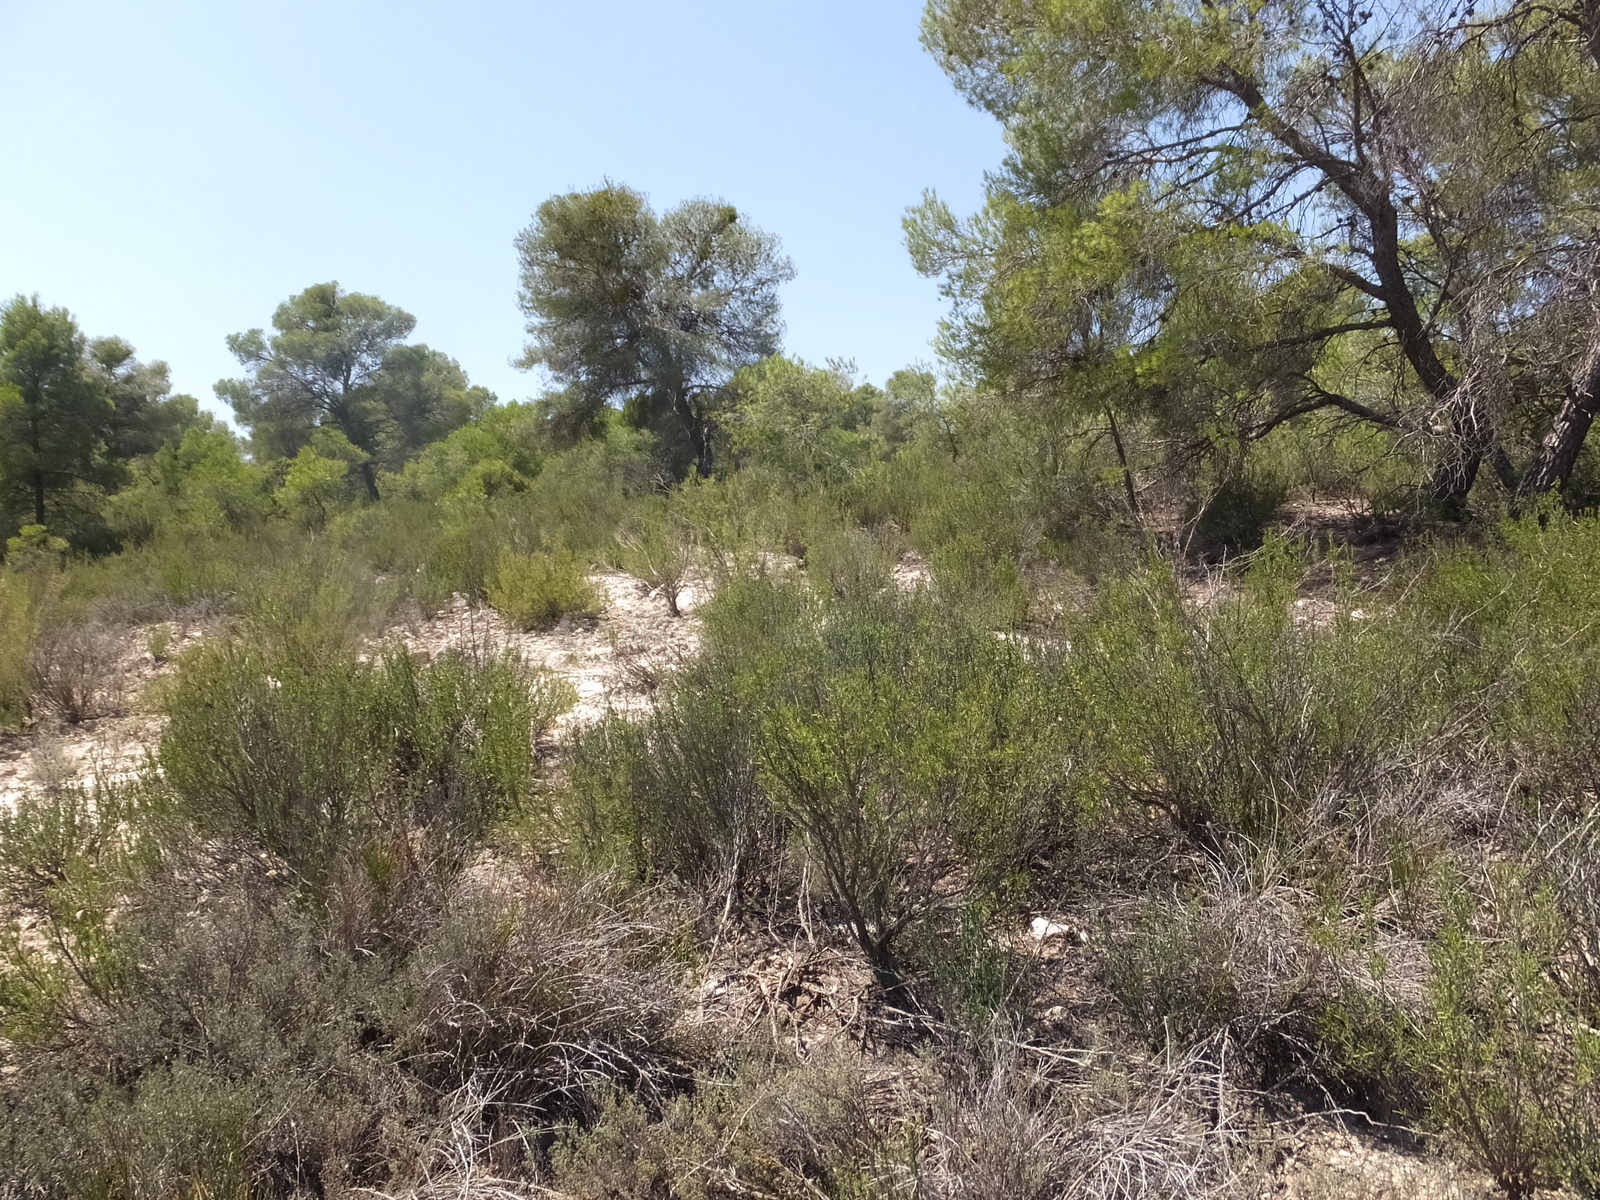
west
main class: Shrubland
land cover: Shrubland with sparse tree cover
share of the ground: > 75 %
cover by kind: shrubs 60 %, herbaceous plants 35 %, coniferous forest trees 5 %
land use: Semi-natural and natural areas not in use
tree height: < 5 m
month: August
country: ES
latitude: 41.4010
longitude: 0.0708
